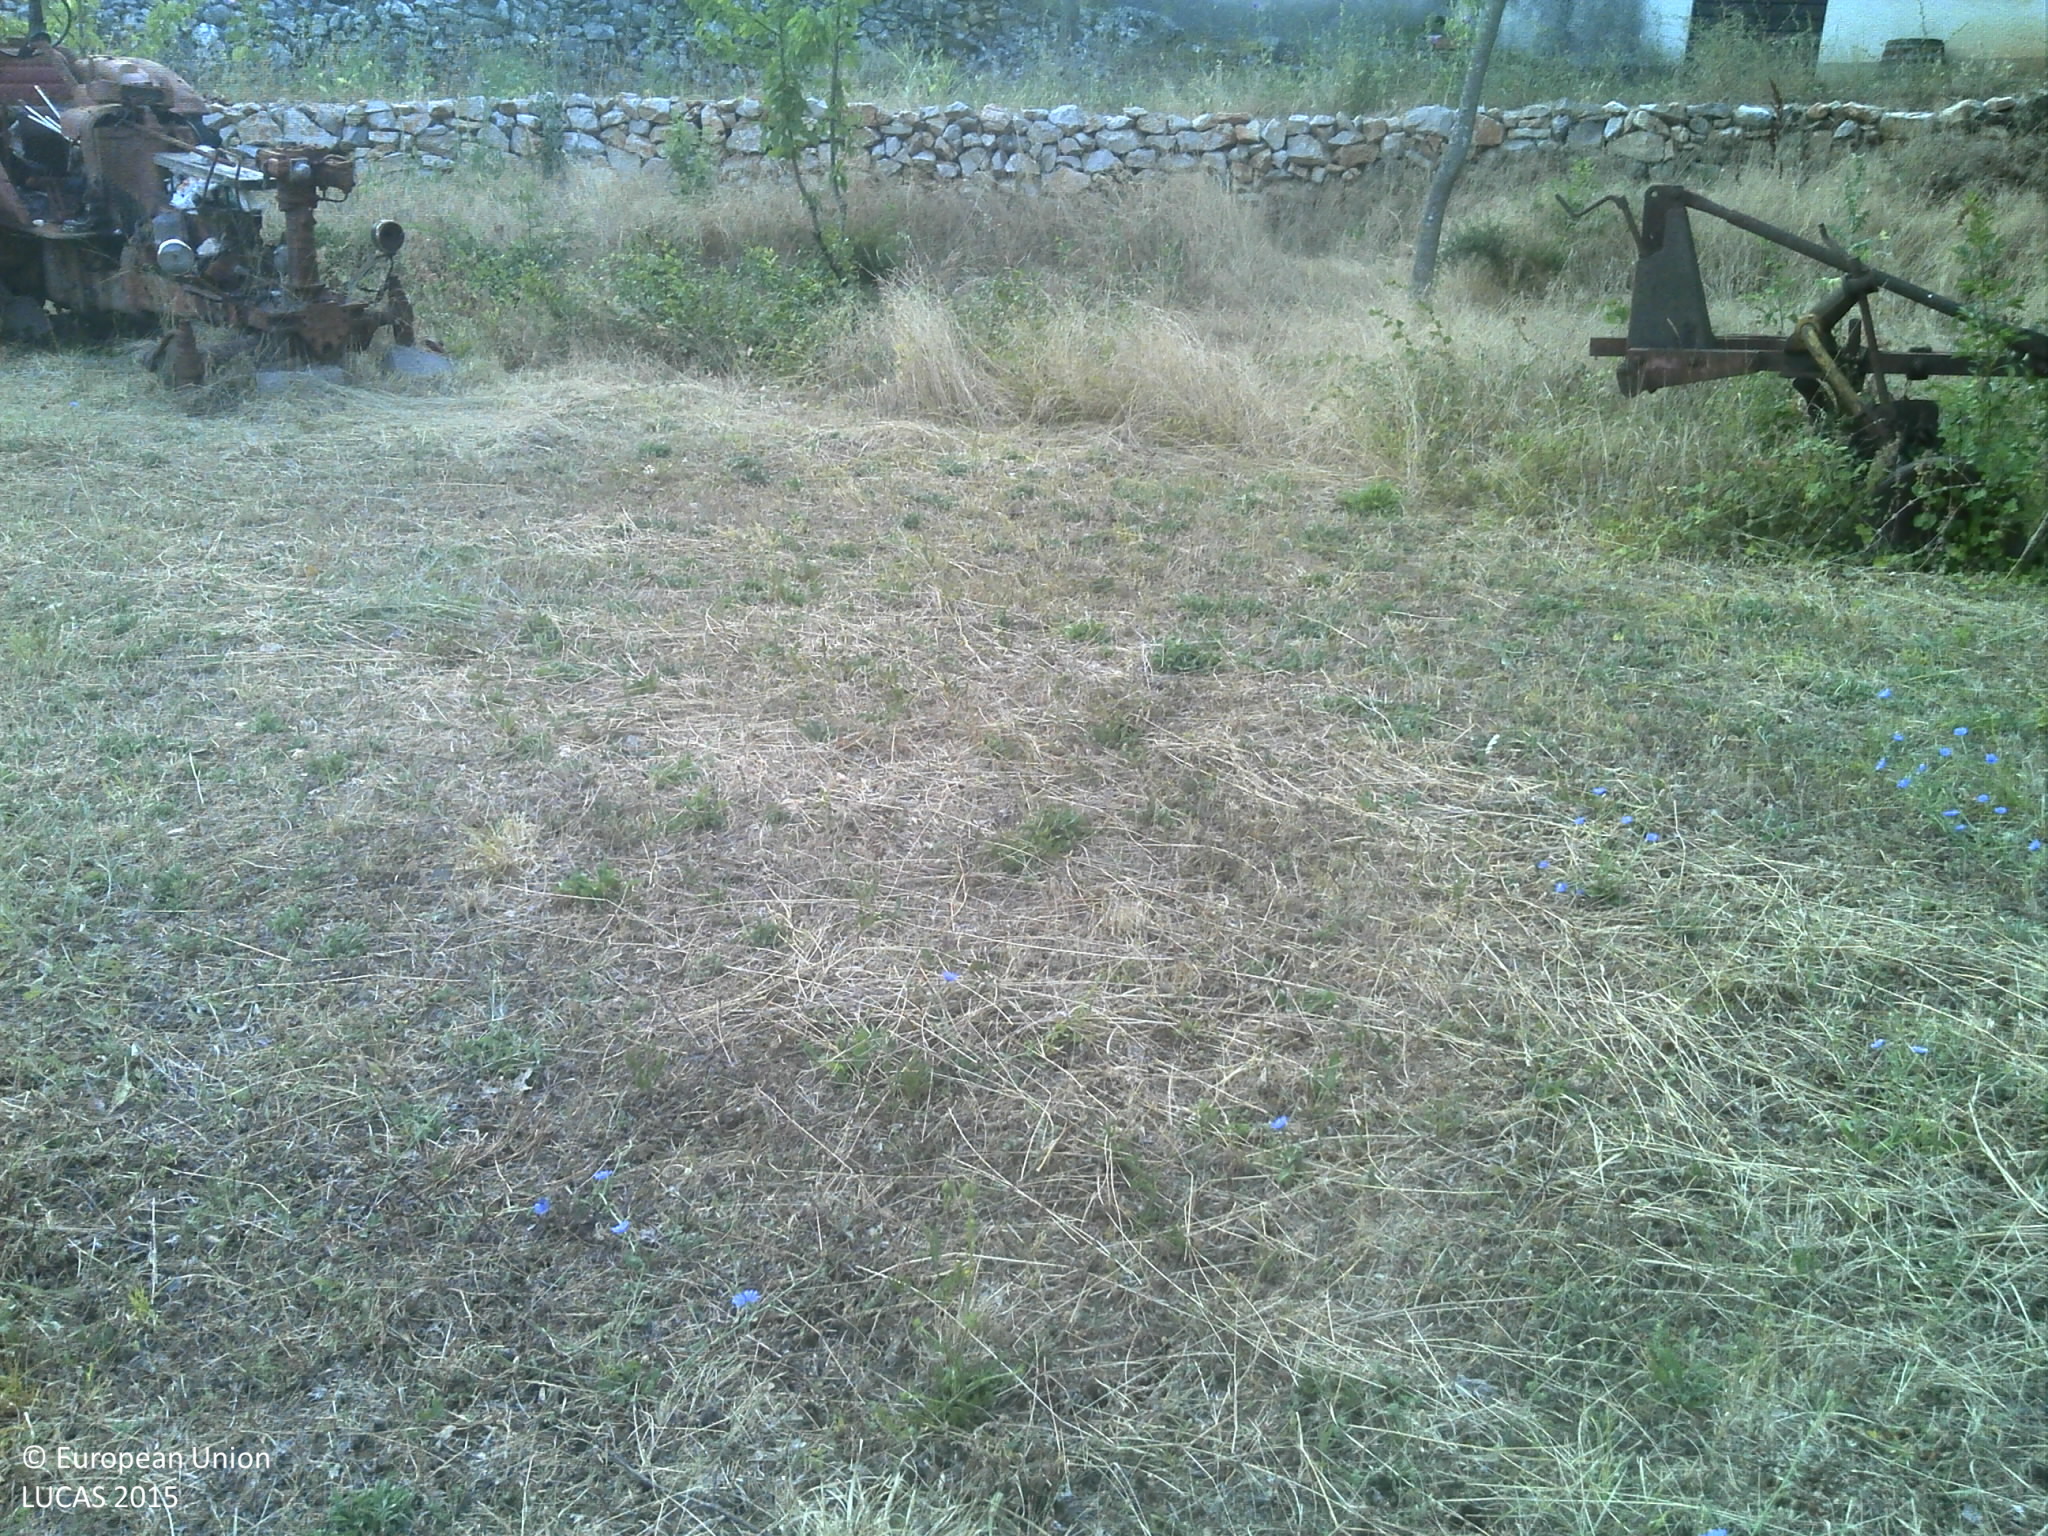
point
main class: Grassland
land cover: Grassland without tree/shrub cover
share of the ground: > 75 %
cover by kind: herbaceous plants 95 %, shrubs 5 %
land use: Agriculture (excluding fallow land and kitchen gardens)
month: July
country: HR
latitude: 43.4145
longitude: 17.1671
